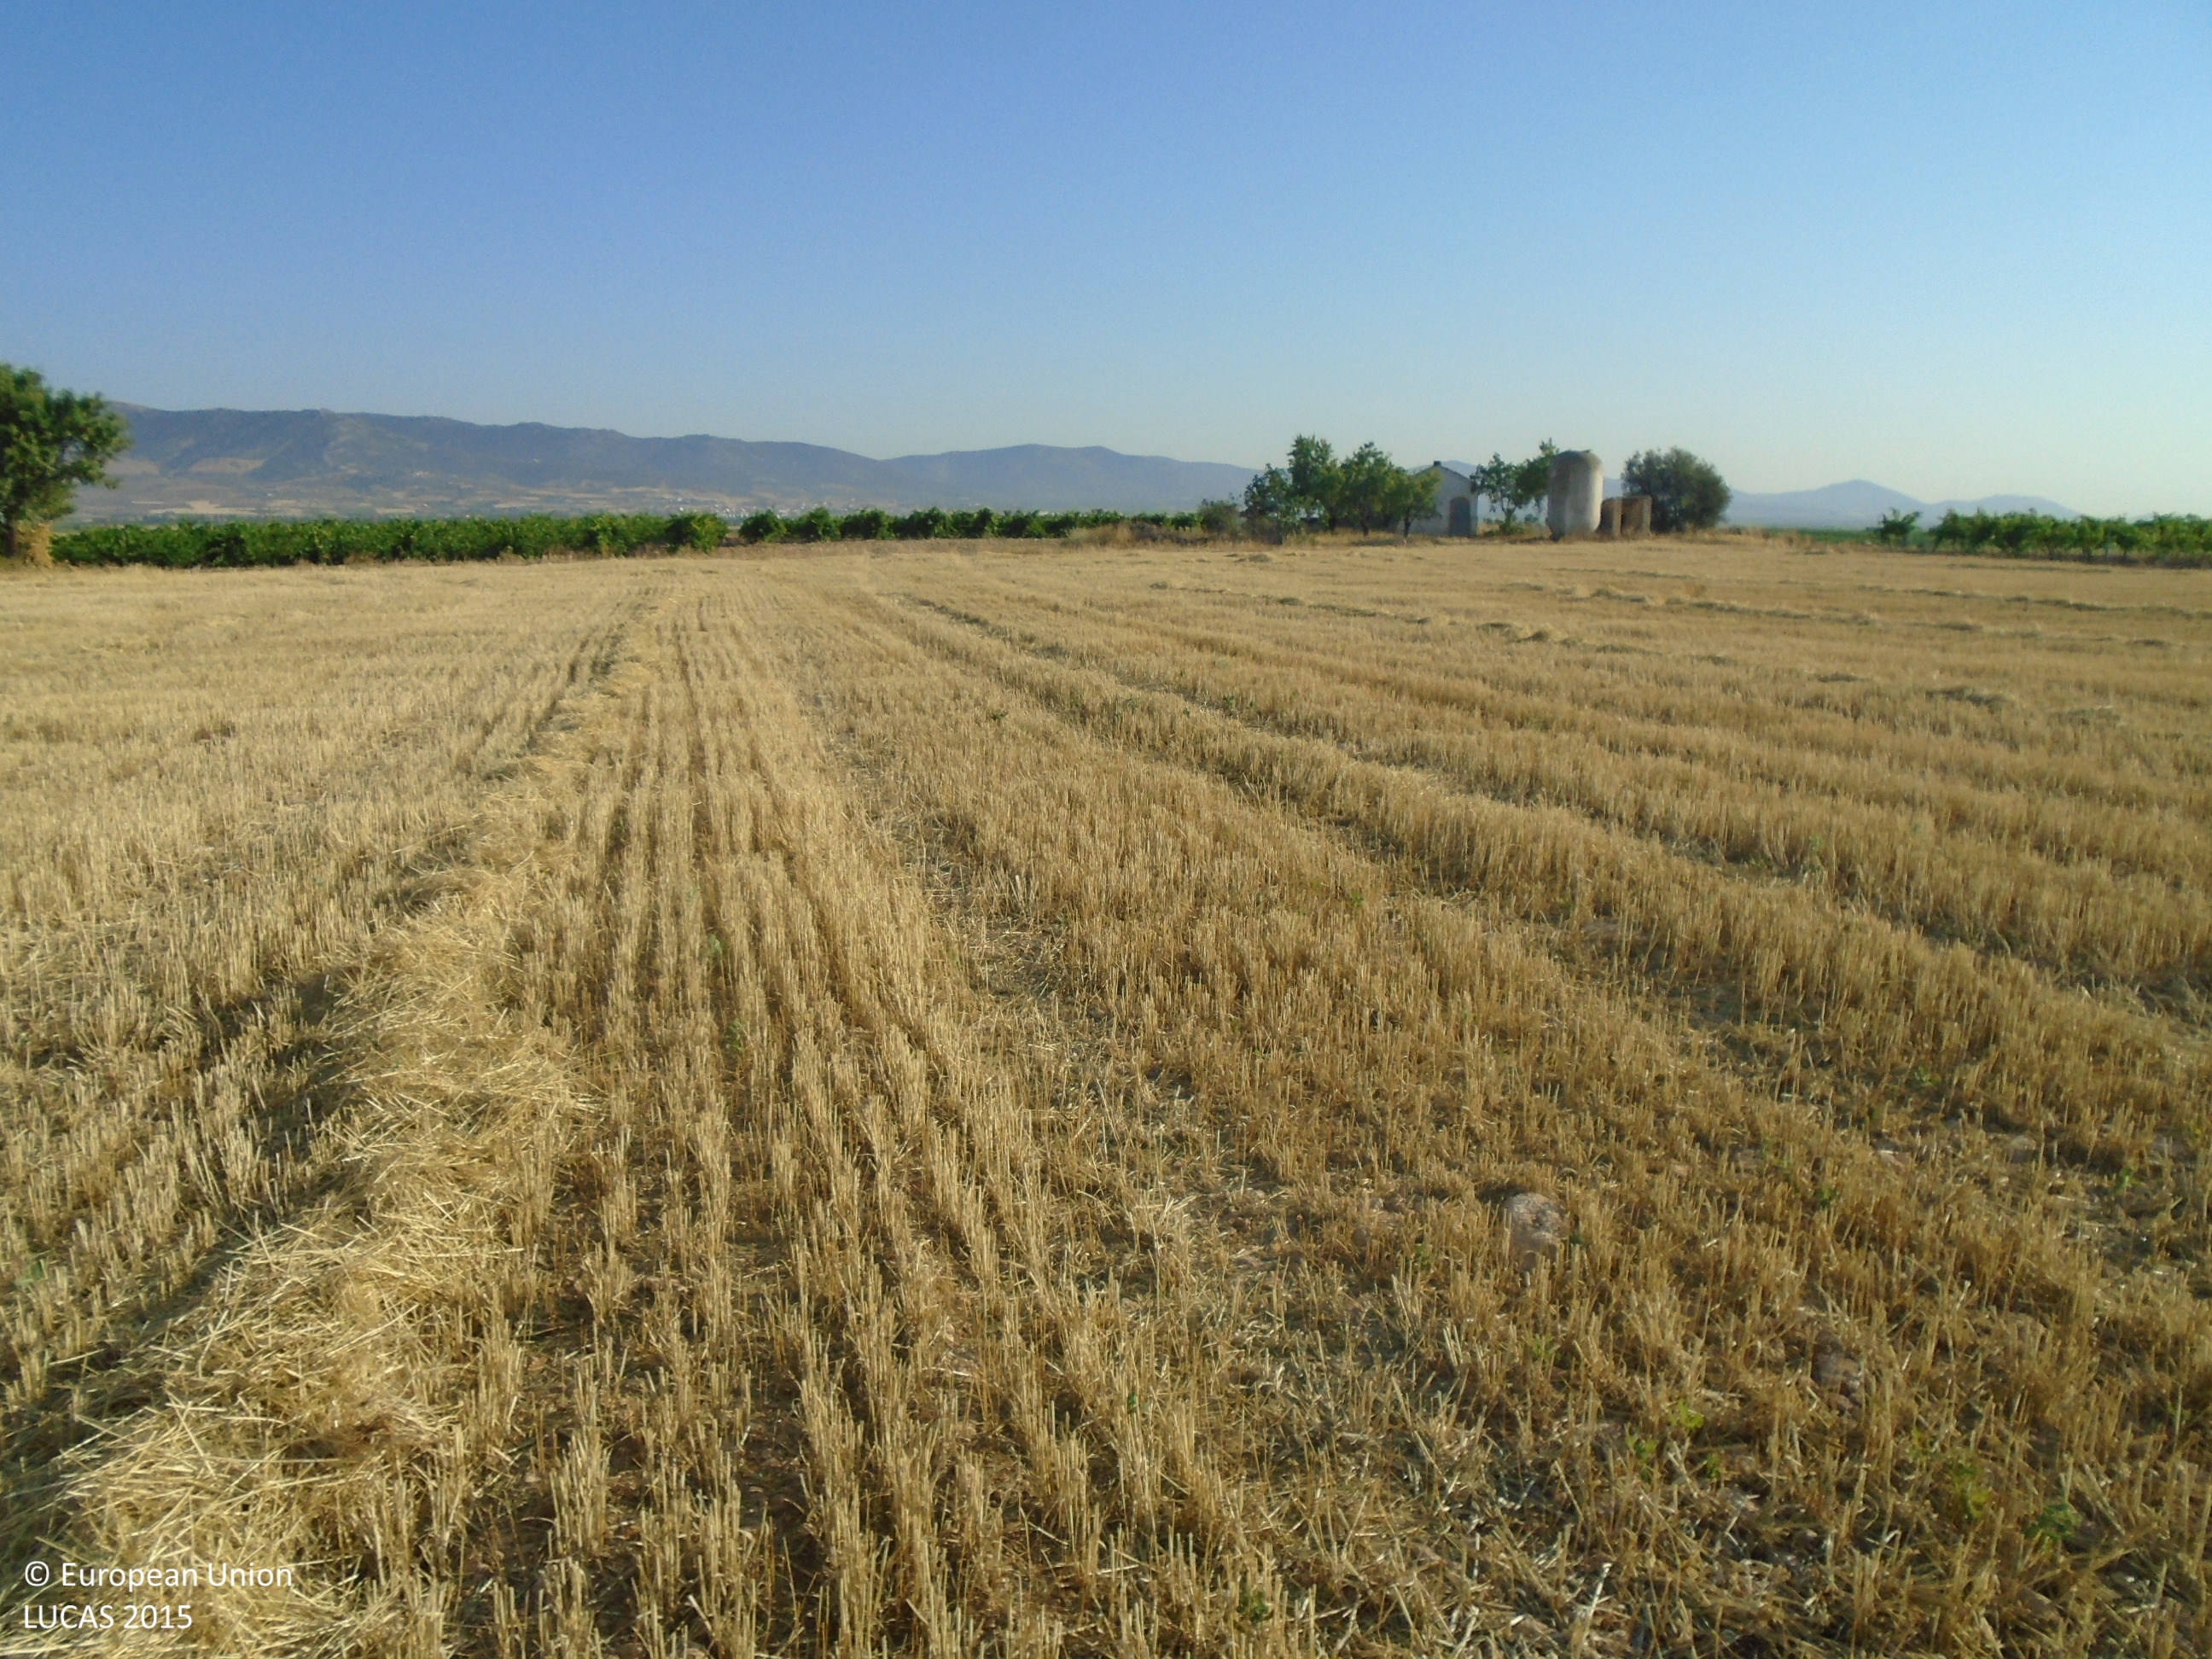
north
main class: Cropland
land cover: Barley
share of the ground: > 75 %
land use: Agriculture (excluding fallow land and kitchen gardens)
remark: Harvested field
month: June
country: ES
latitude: 39.1694
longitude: -3.5959
